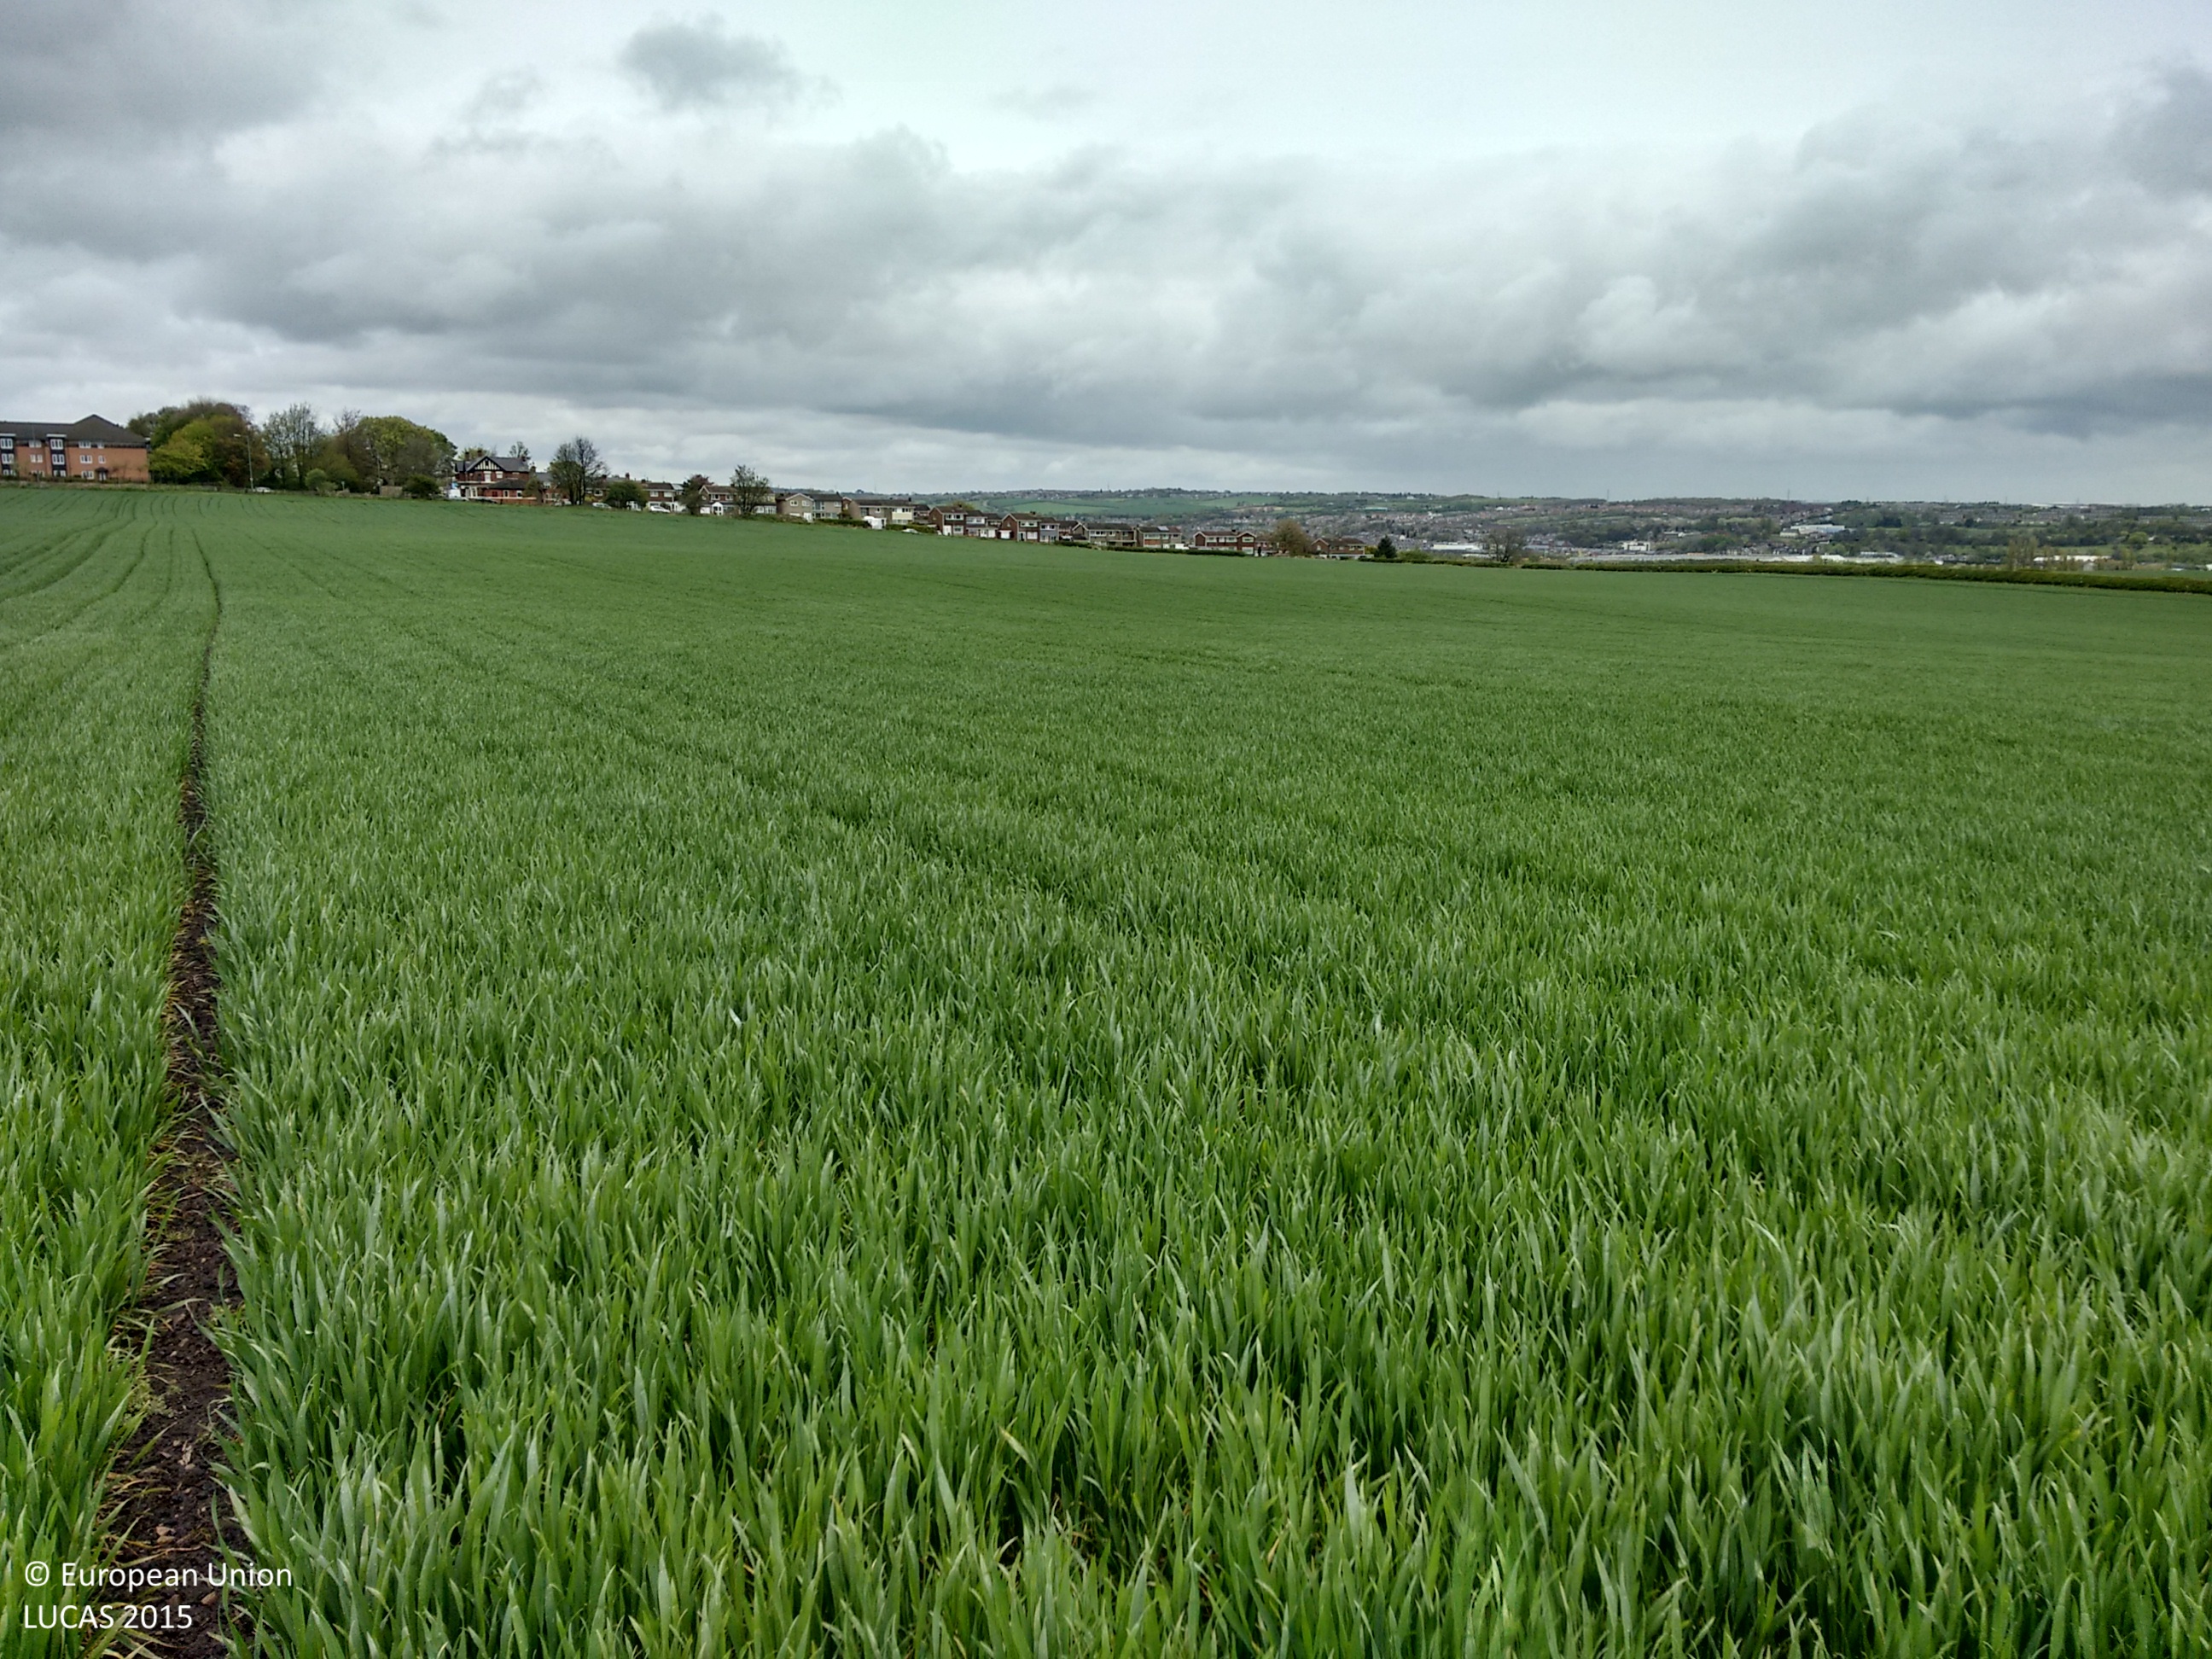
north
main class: Cropland
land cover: Common wheat
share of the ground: > 75 %
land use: Agriculture (excluding fallow land and kitchen gardens)
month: May
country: GB
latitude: 54.8780
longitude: -1.5979
